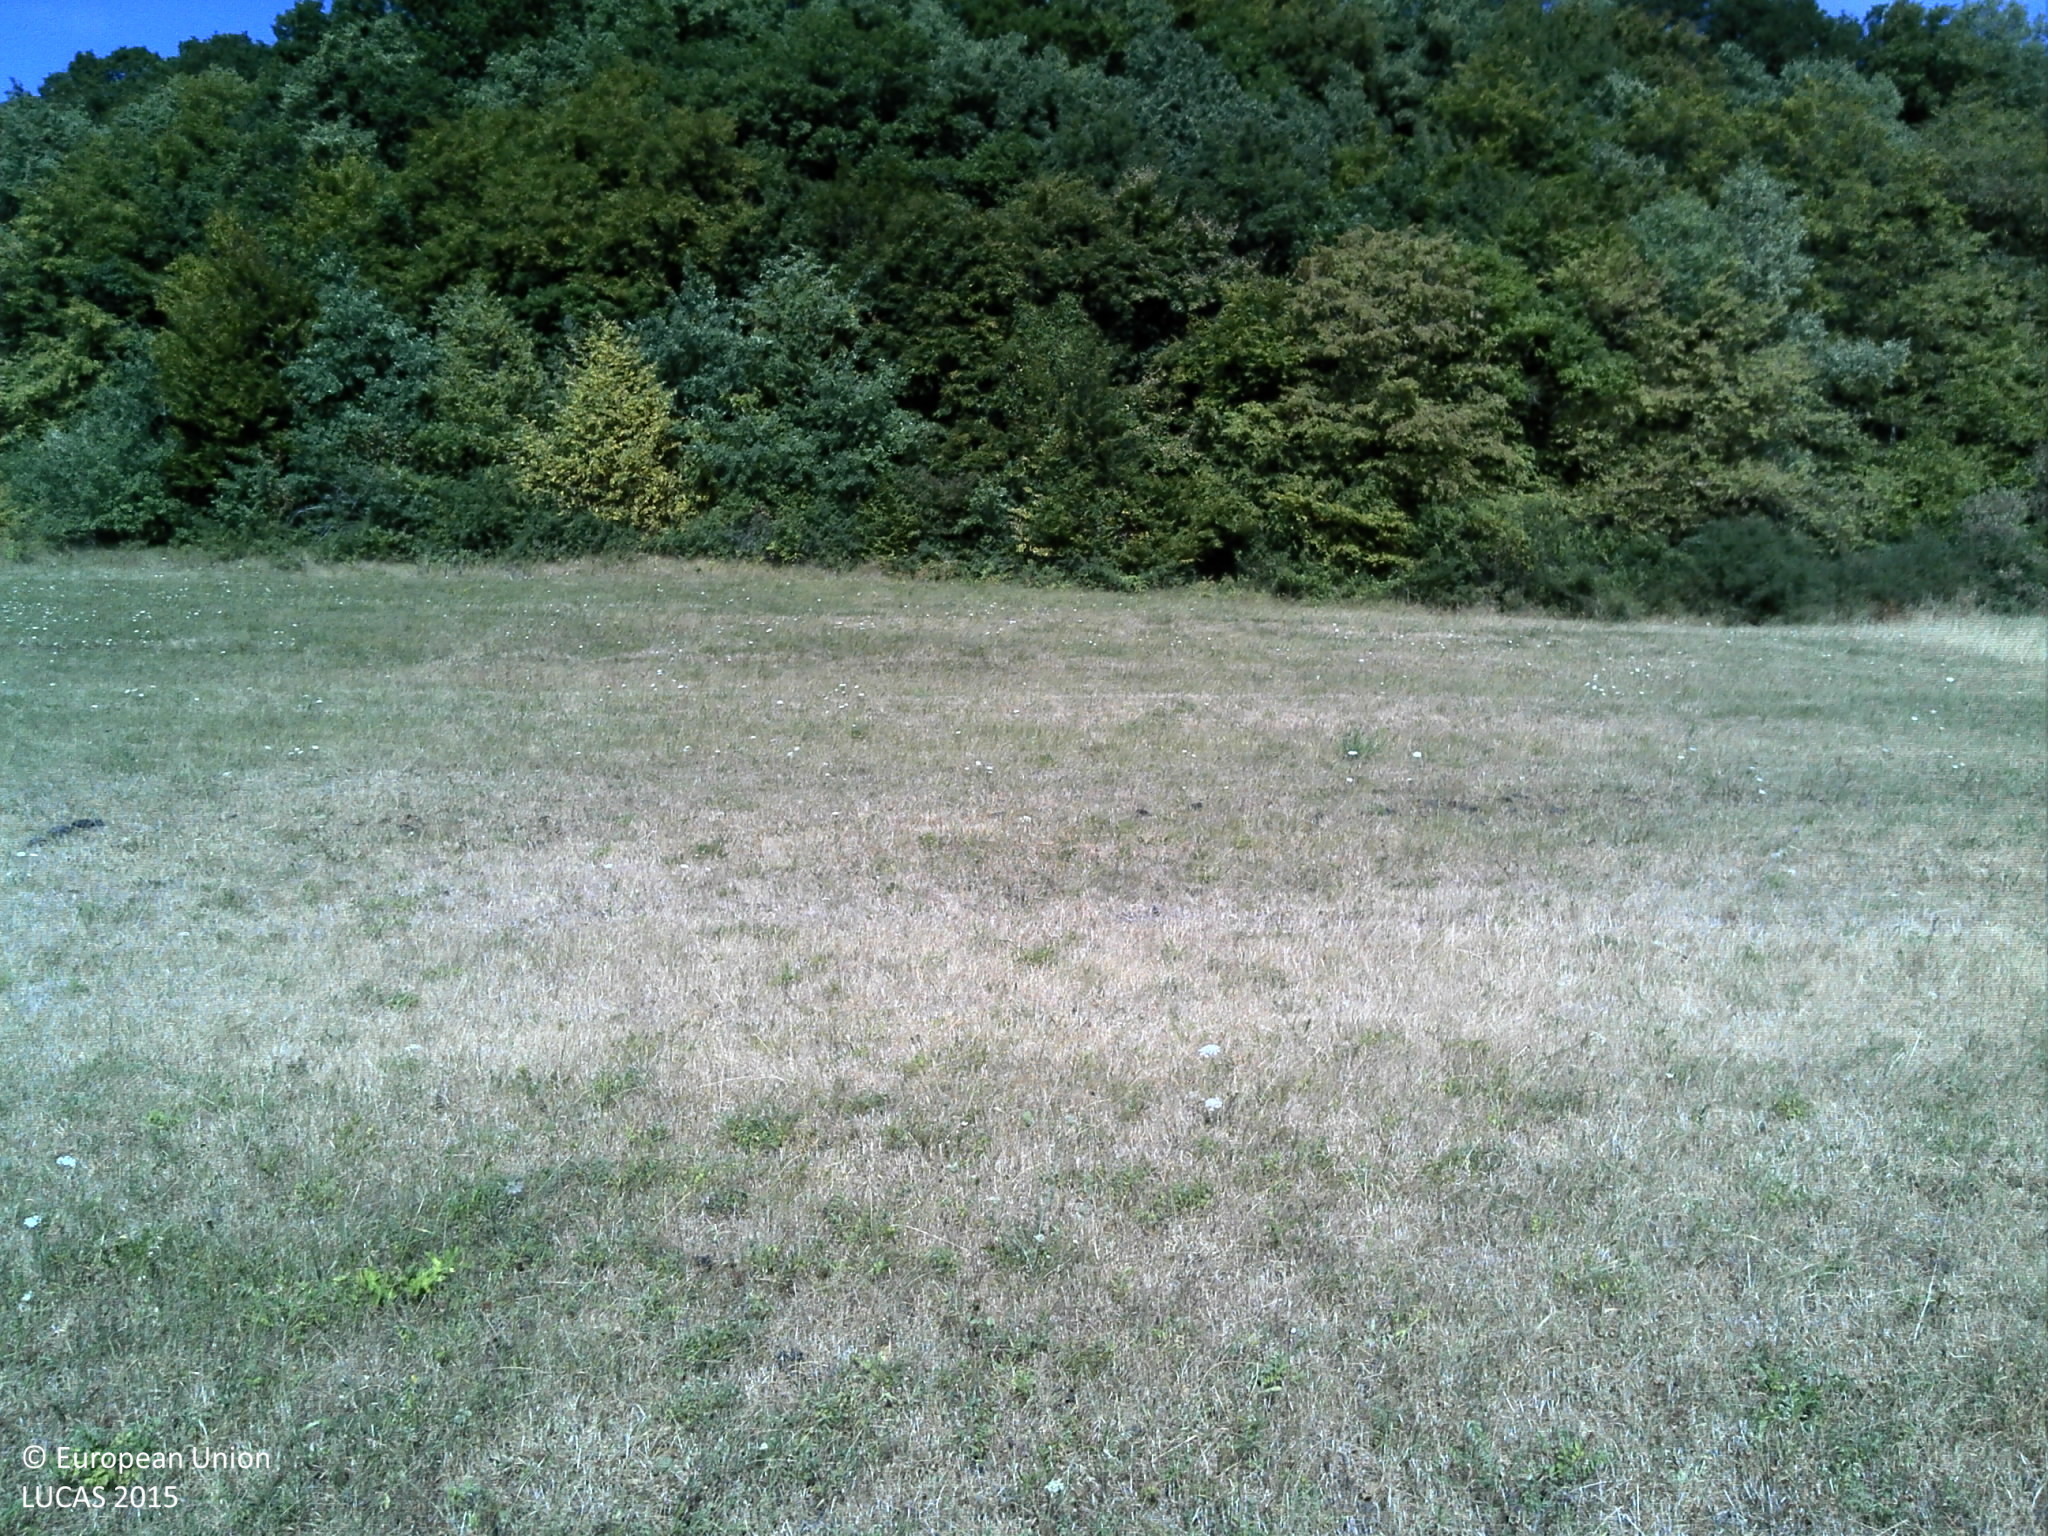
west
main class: Grassland
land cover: Grassland without tree/shrub cover
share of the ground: > 75 %
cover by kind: herbaceous plants 100 %
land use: Agriculture (excluding fallow land and kitchen gardens)
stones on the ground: 10 - 25 %
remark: Harvested field
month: July
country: FR
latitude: 48.2401
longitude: 5.9742
